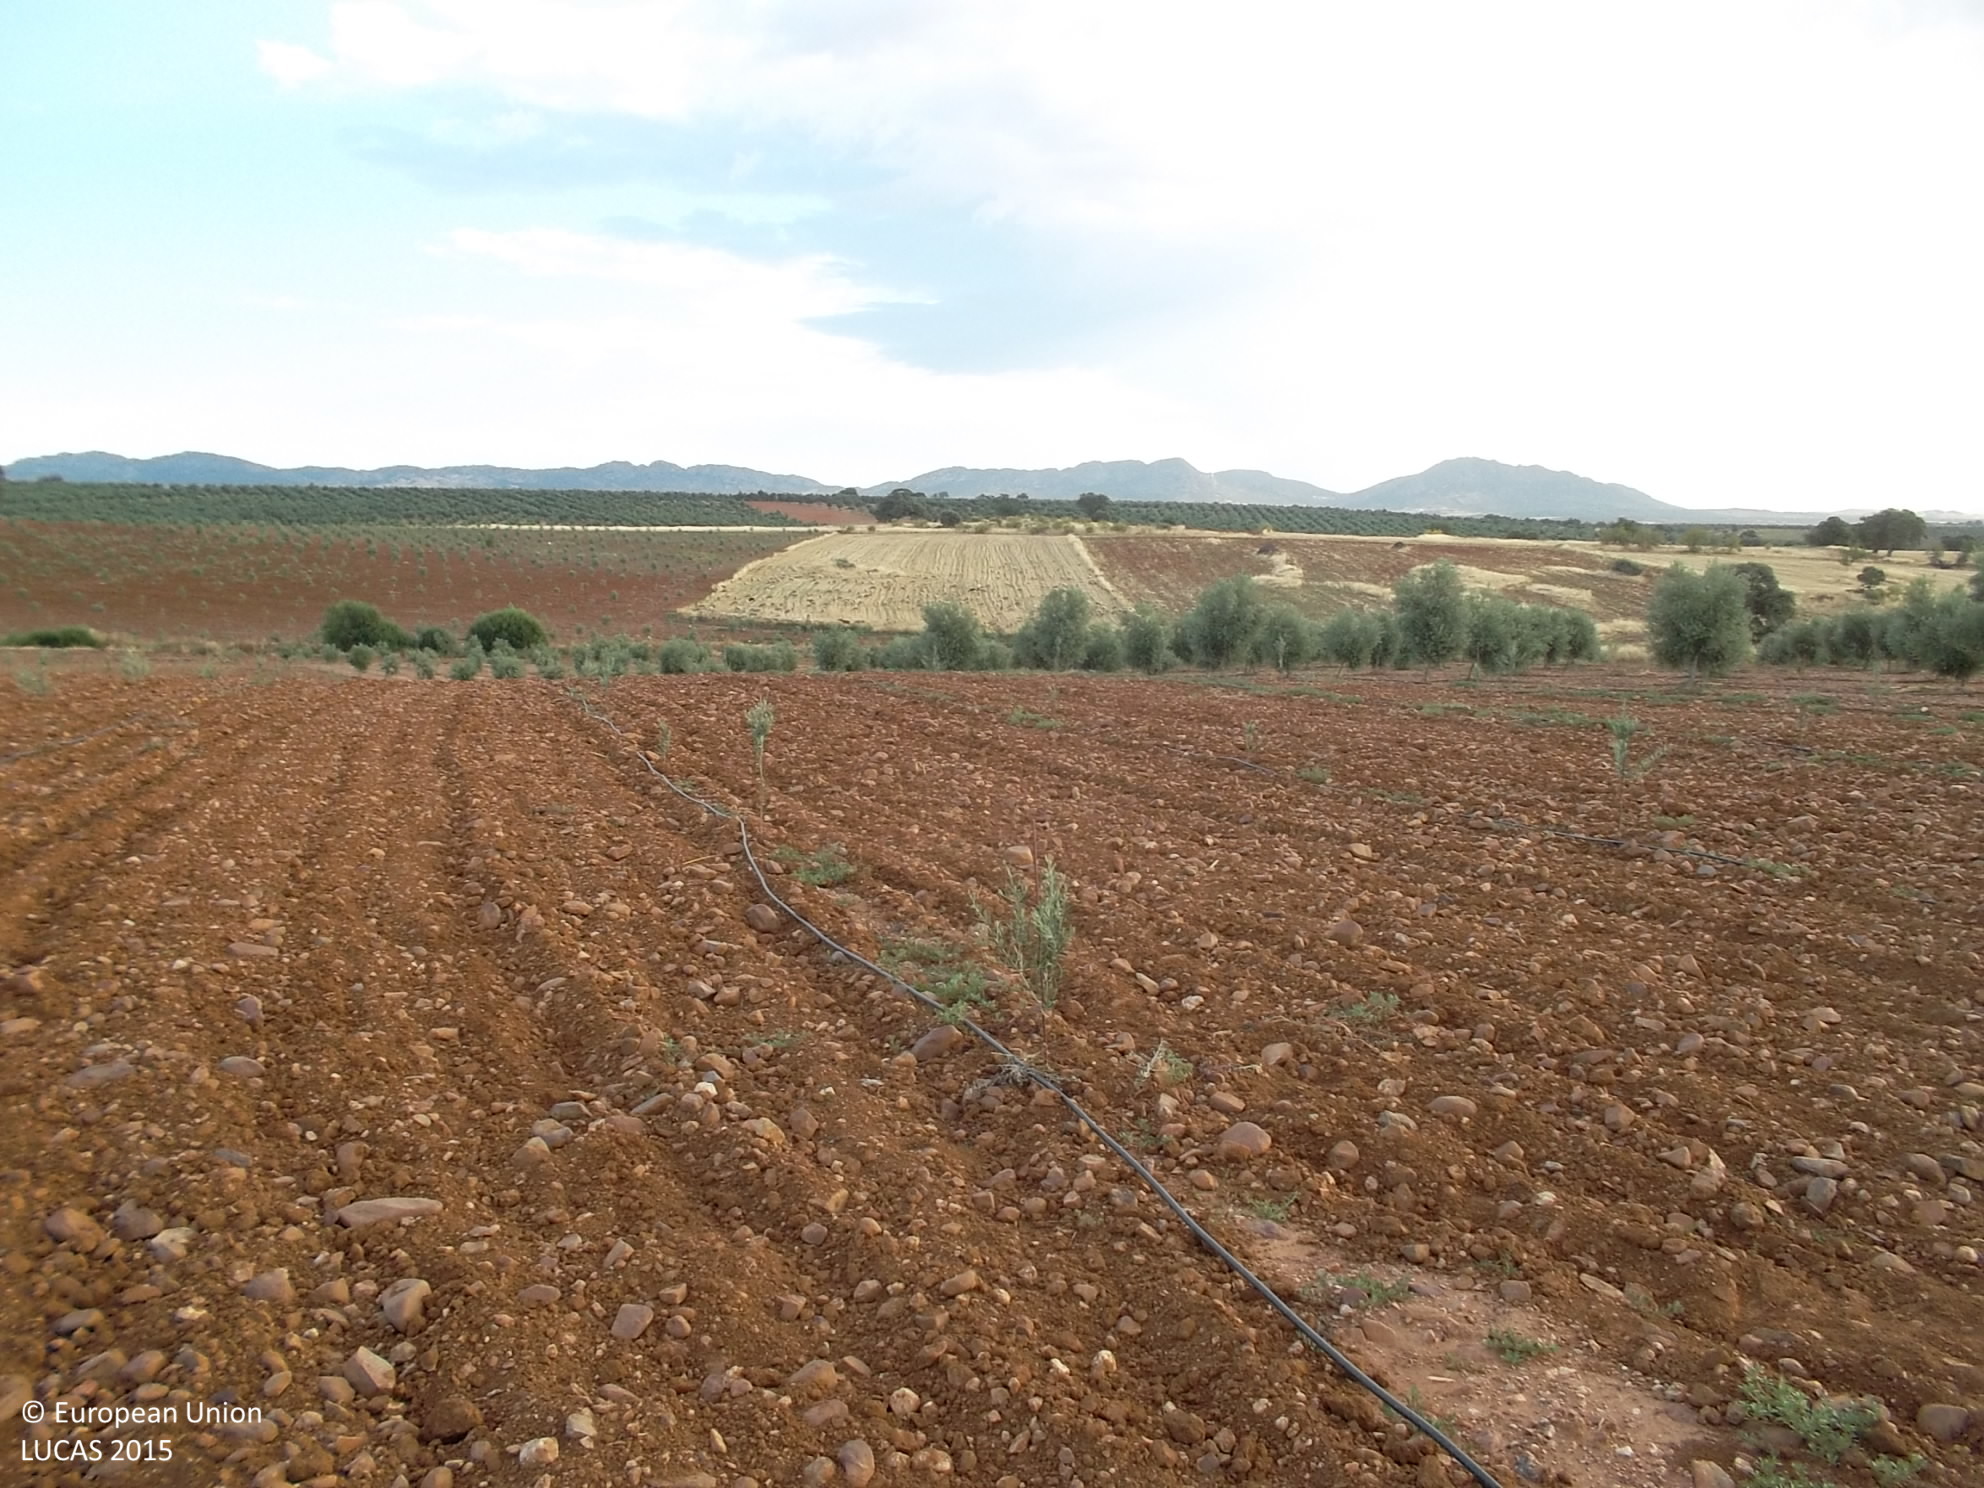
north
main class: Cropland
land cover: Olive groves
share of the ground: 10 - 25 %
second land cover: Other bare soil
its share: > 75 %
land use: Agriculture (excluding fallow land and kitchen gardens)
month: July
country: ES
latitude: 38.6002
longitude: -5.4105
